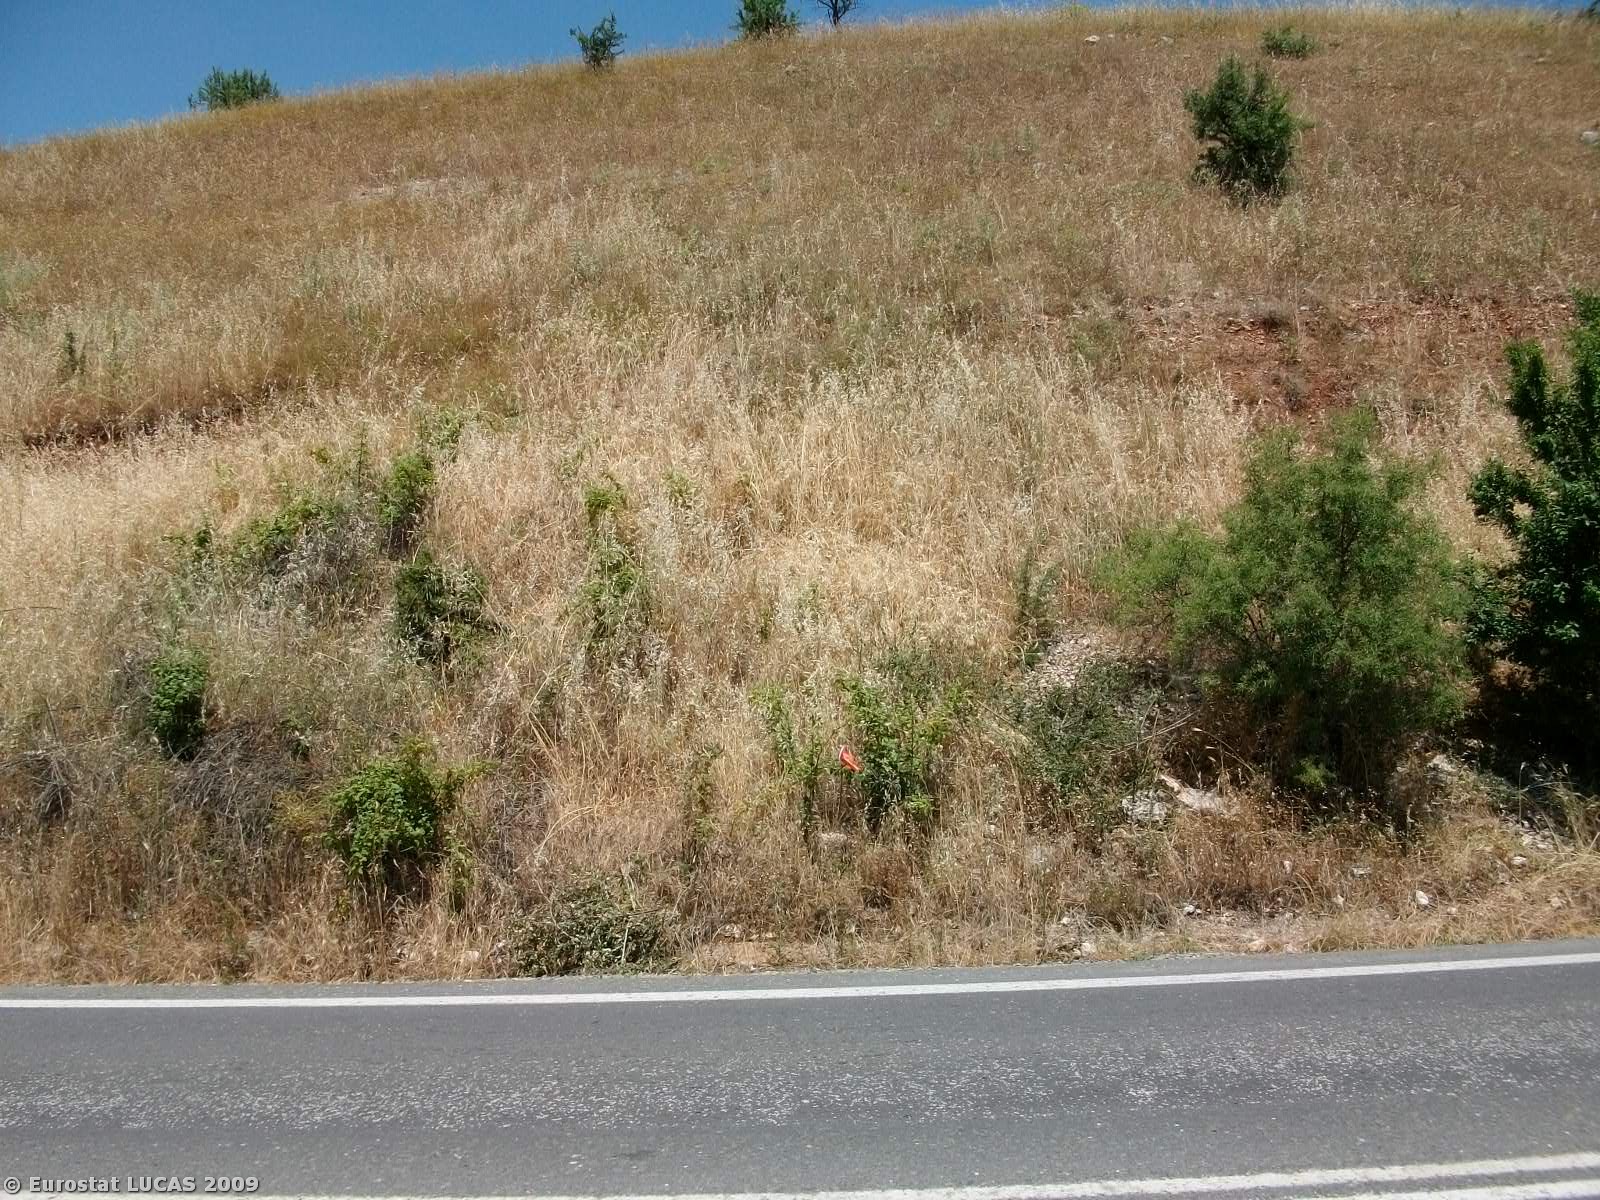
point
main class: Grassland
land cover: Grassland without tree/shrub cover
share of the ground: 25 - 50 %
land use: Fallow land
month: June
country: GR
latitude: 37.3525
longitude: 22.4120
